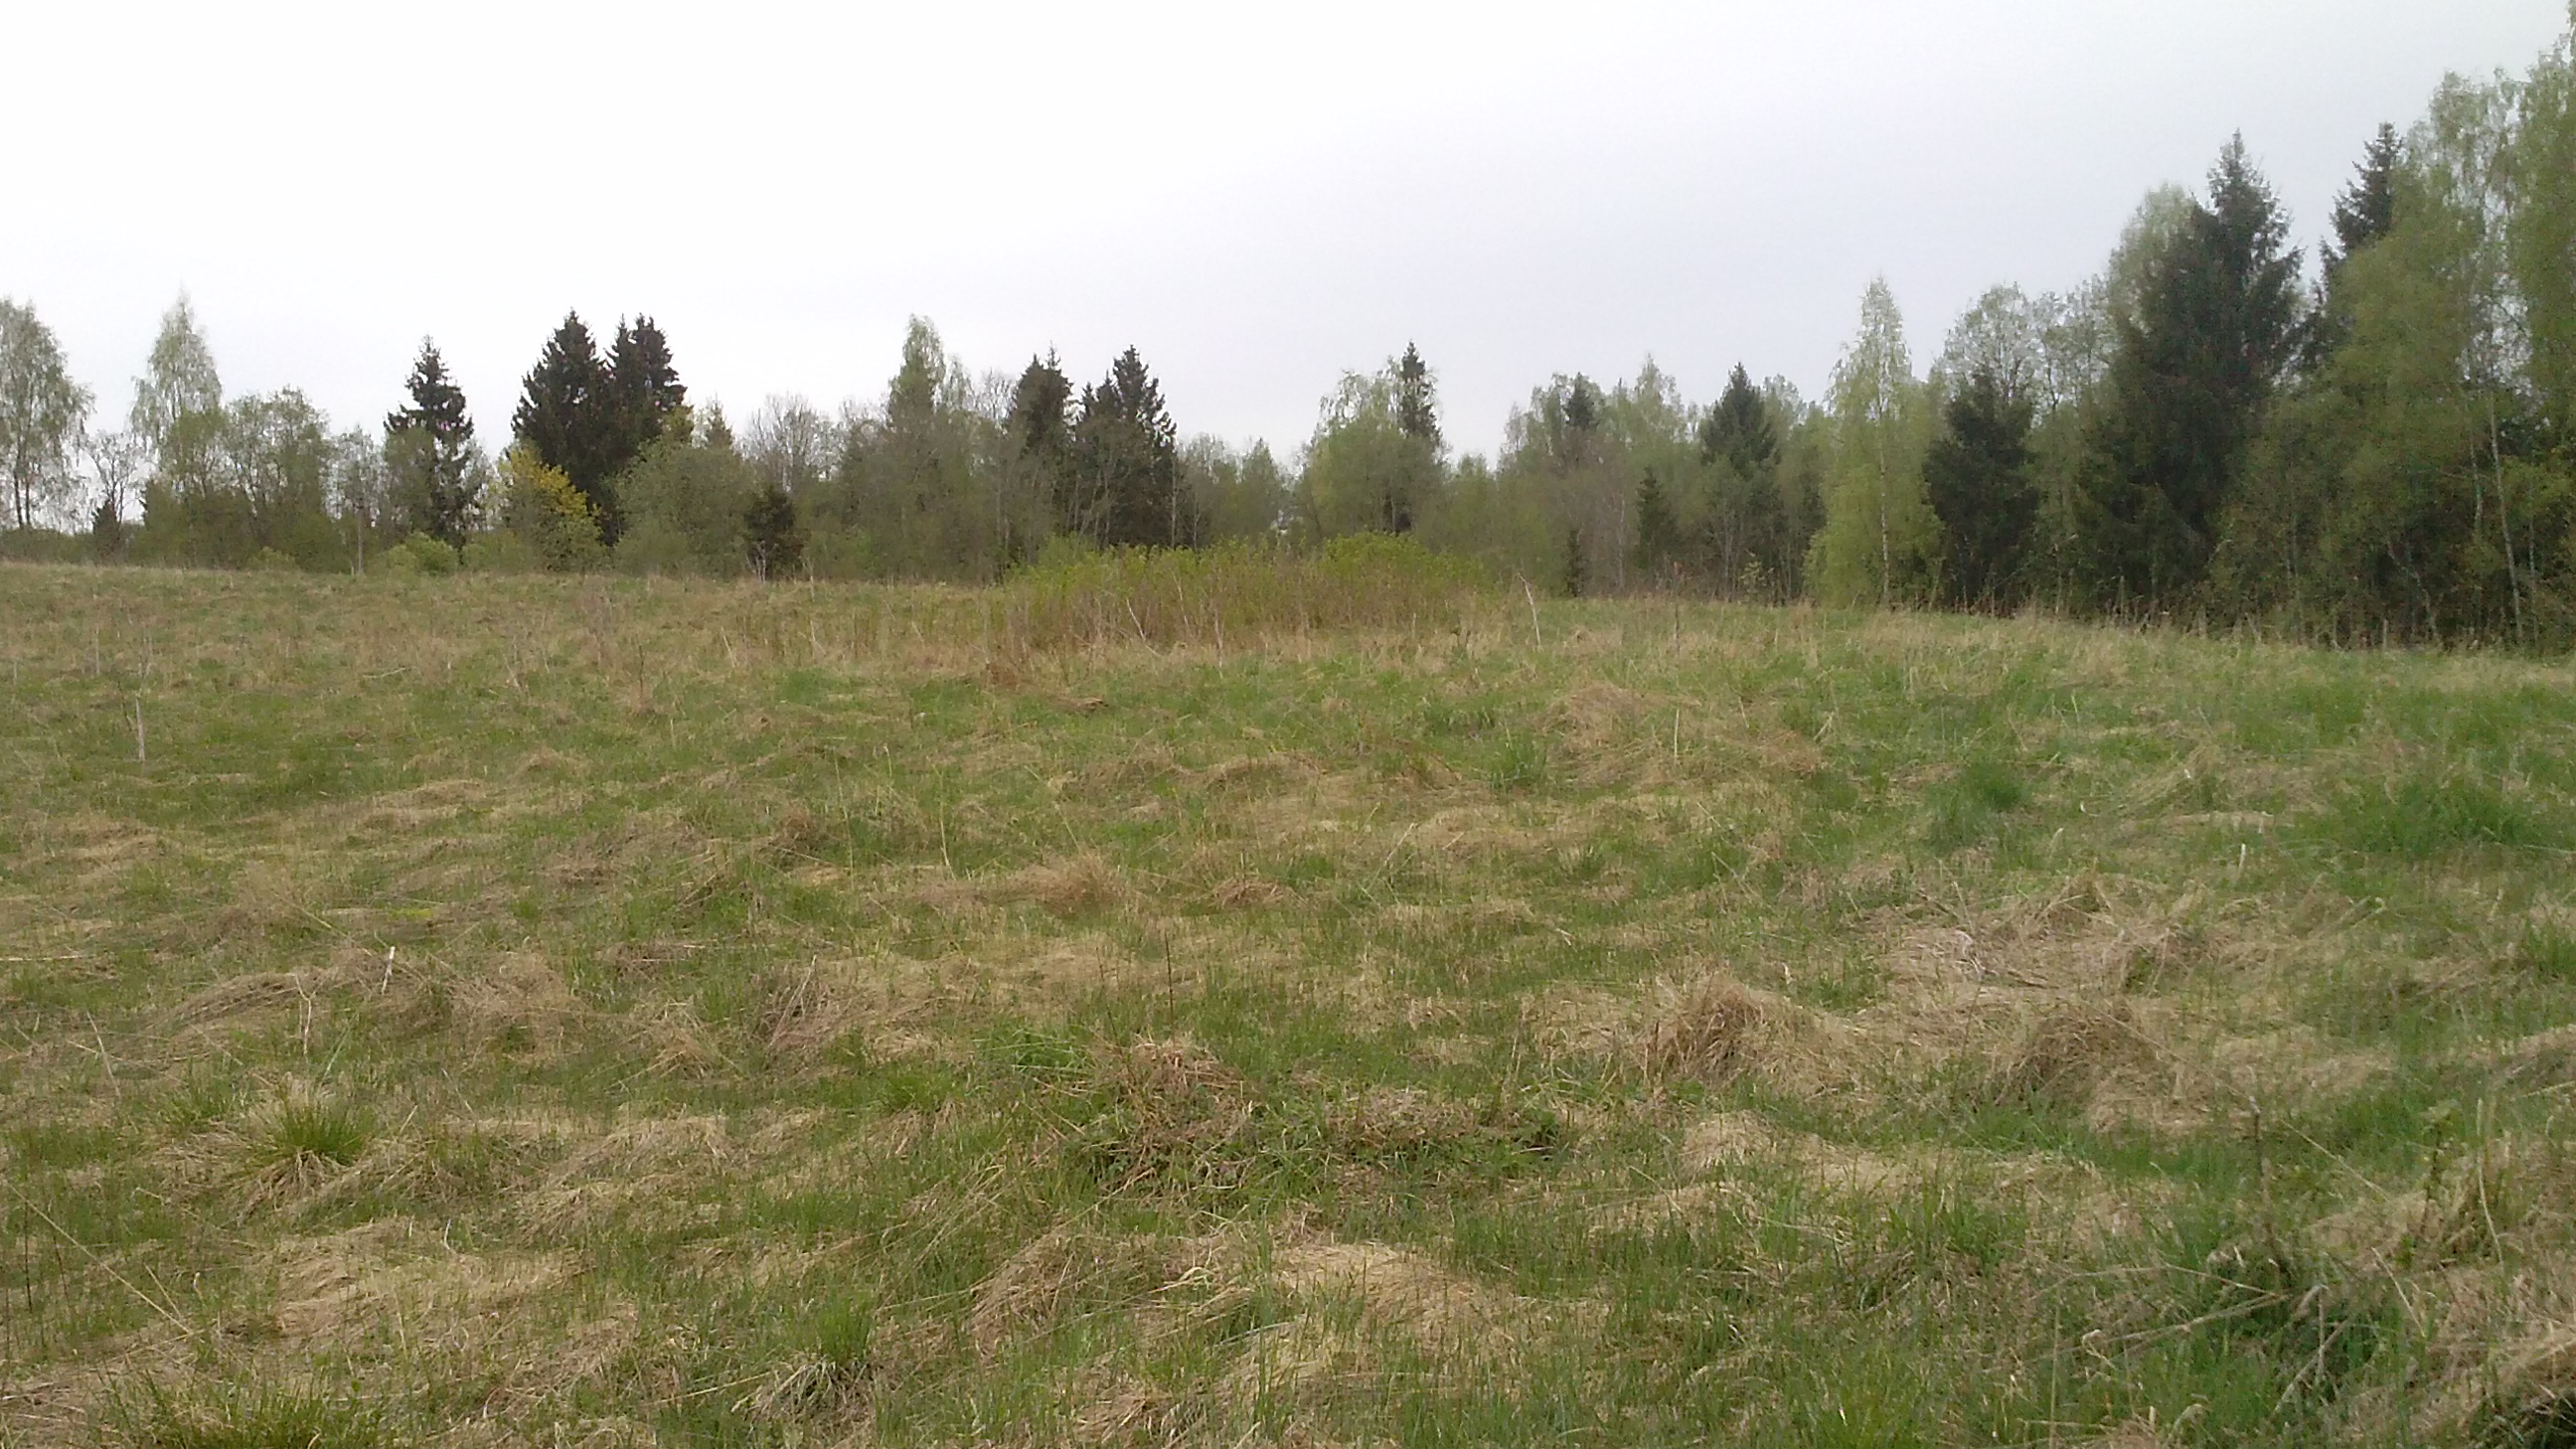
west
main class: Grassland
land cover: Grassland without tree/shrub cover
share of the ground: > 75 %
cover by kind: herbaceous plants 100 %
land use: Agriculture (excluding fallow land and kitchen gardens)
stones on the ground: < 10 %
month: May
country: LV
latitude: 55.9710
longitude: 27.2042
